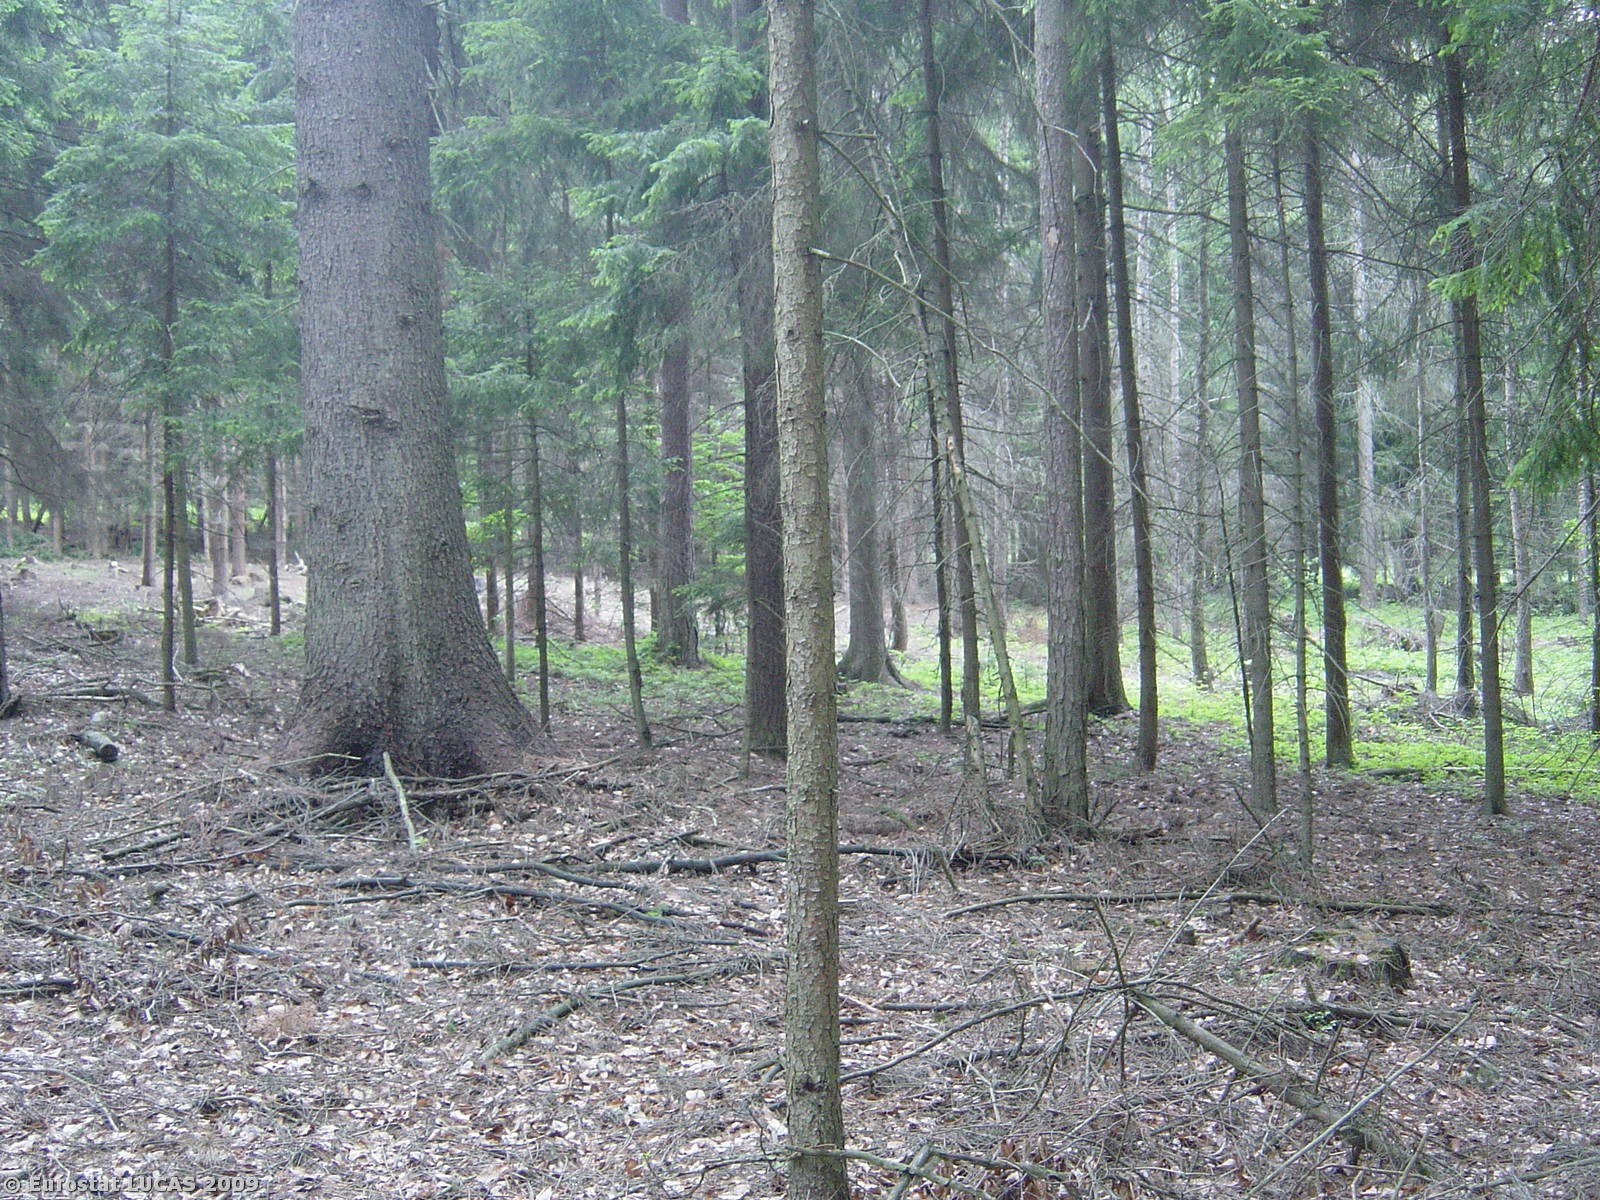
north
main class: Woodland
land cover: Mixed woodland
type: hemiboreal forest and nemoral coniferous forest and mixed broadleaved-coniferous forest
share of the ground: > 75 %
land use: Forestry
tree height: > 5 m
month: June
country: CZ
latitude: 49.8884
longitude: 16.5355
